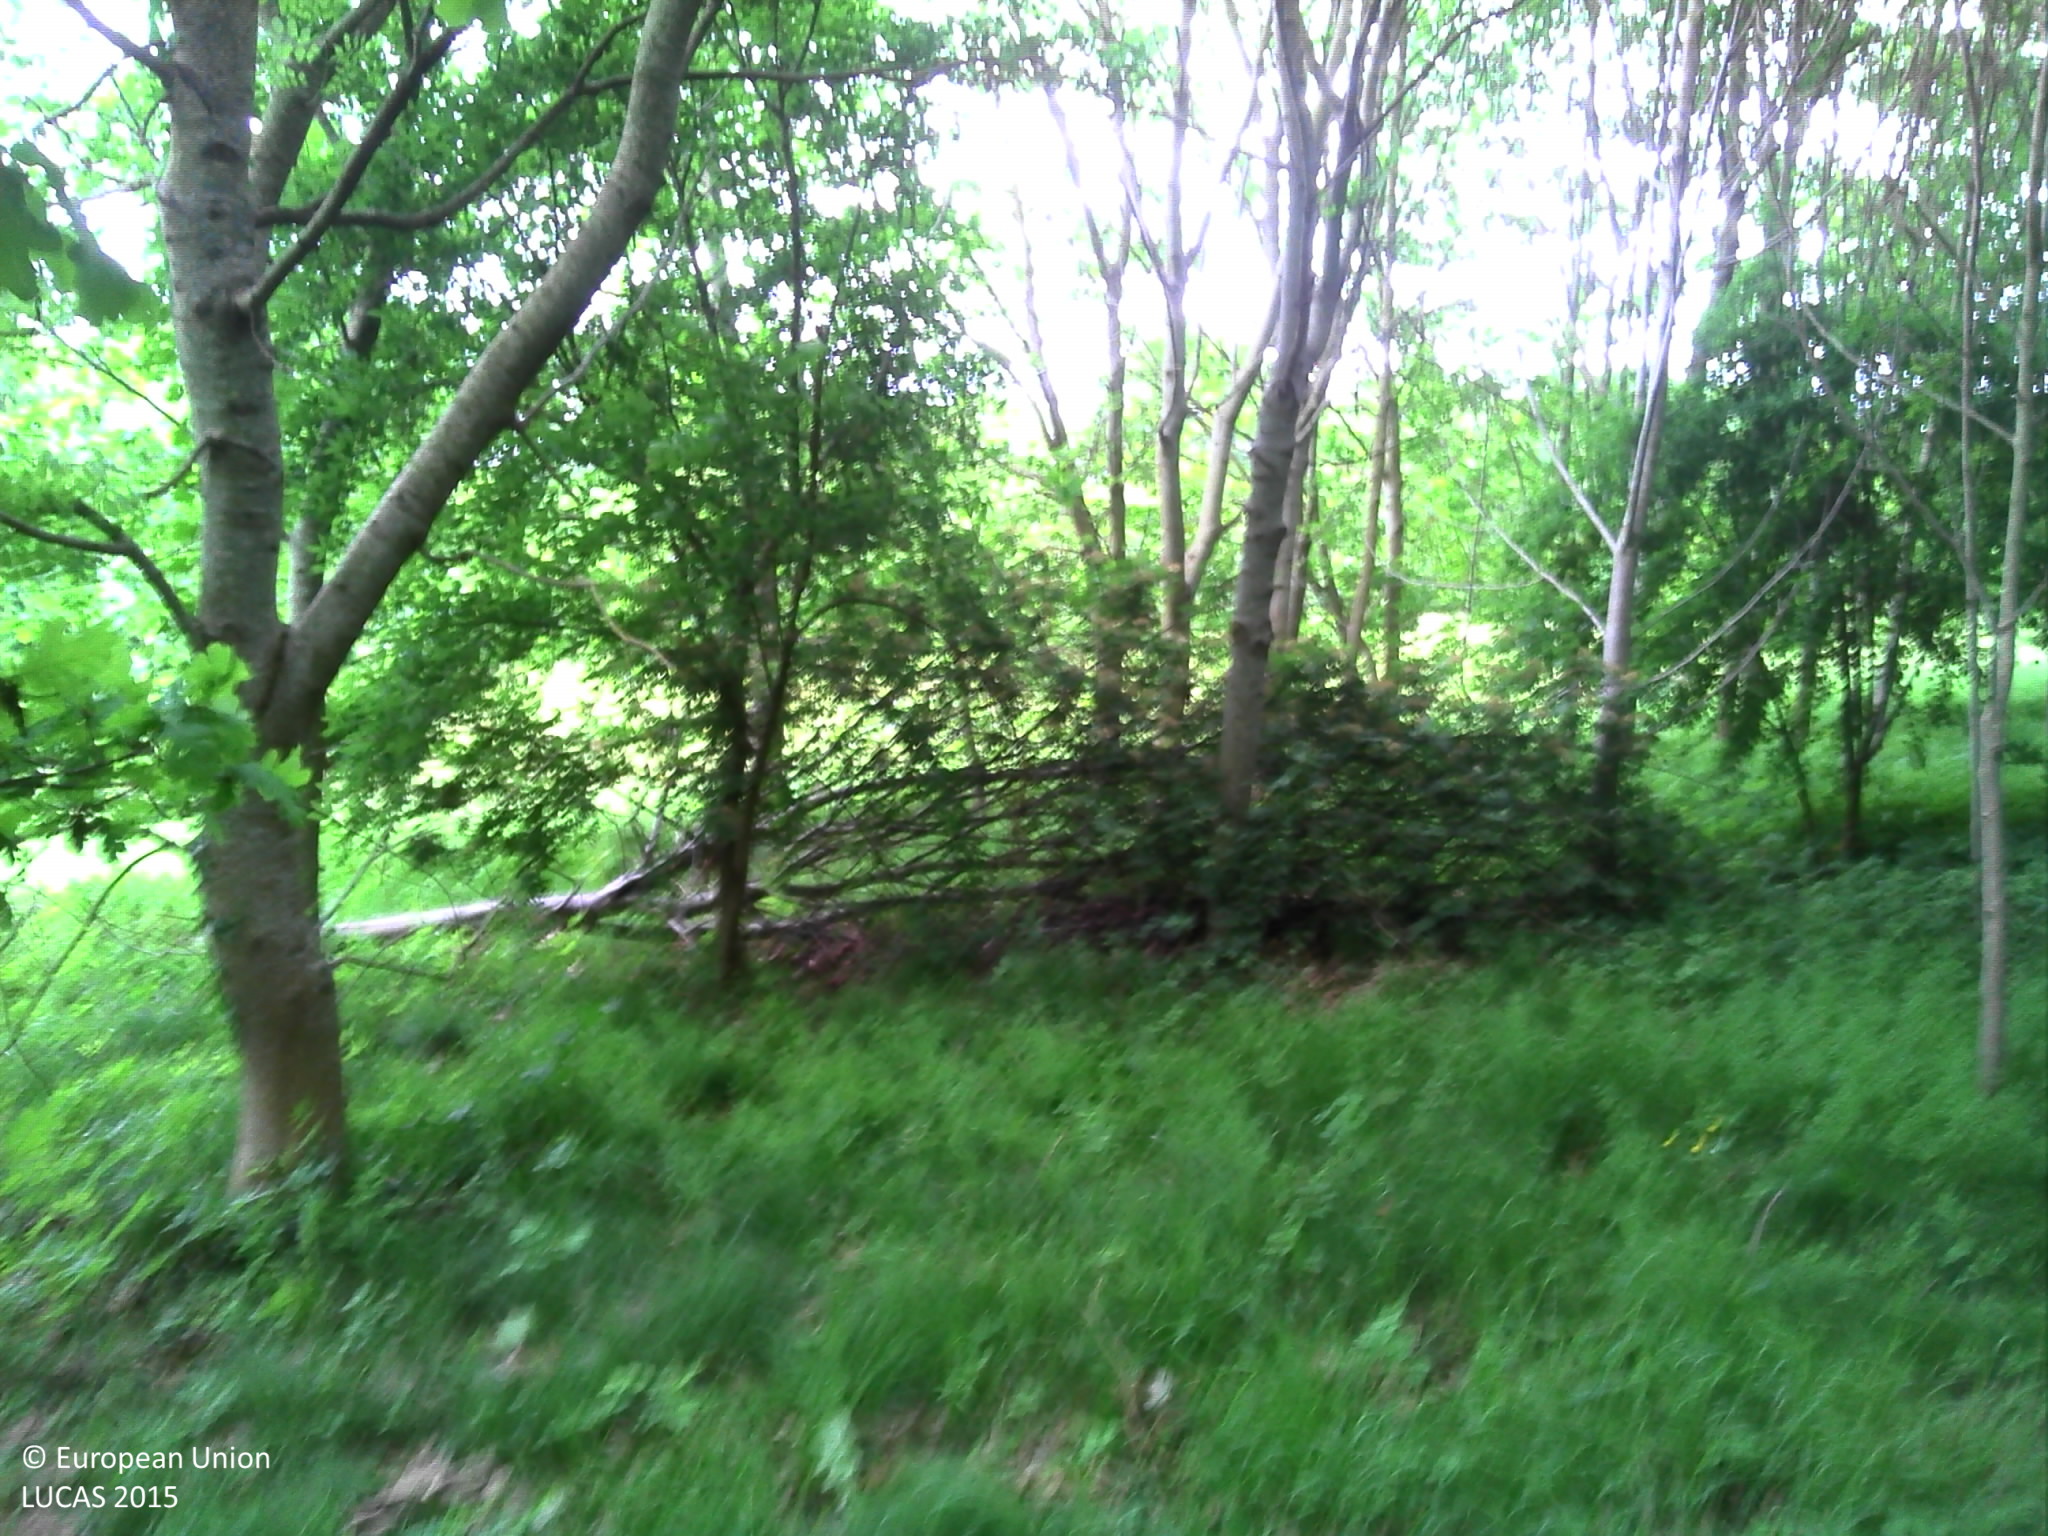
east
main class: Woodland
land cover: Broadleaved woodland
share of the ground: > 75 %
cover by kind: broadleaved forest trees 85 %, shrubs 10 %, herbaceous plants 5 %
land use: Forestry
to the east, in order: Broadleaved woodland; Grassland without tree/shrub cover; Broadleaved woodland; Rivers and streams; Grass margins; Tracks; Grass margins; Grassland with sparse tree/shrub cover; Lines of trees; Ditches and canals; Paved roads, cycling and walking lanes; Grass margins; Apple fruit; Lines of trees; Spontaneously vegetated surfaces
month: May
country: FR
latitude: 49.3107
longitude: 0.0242
